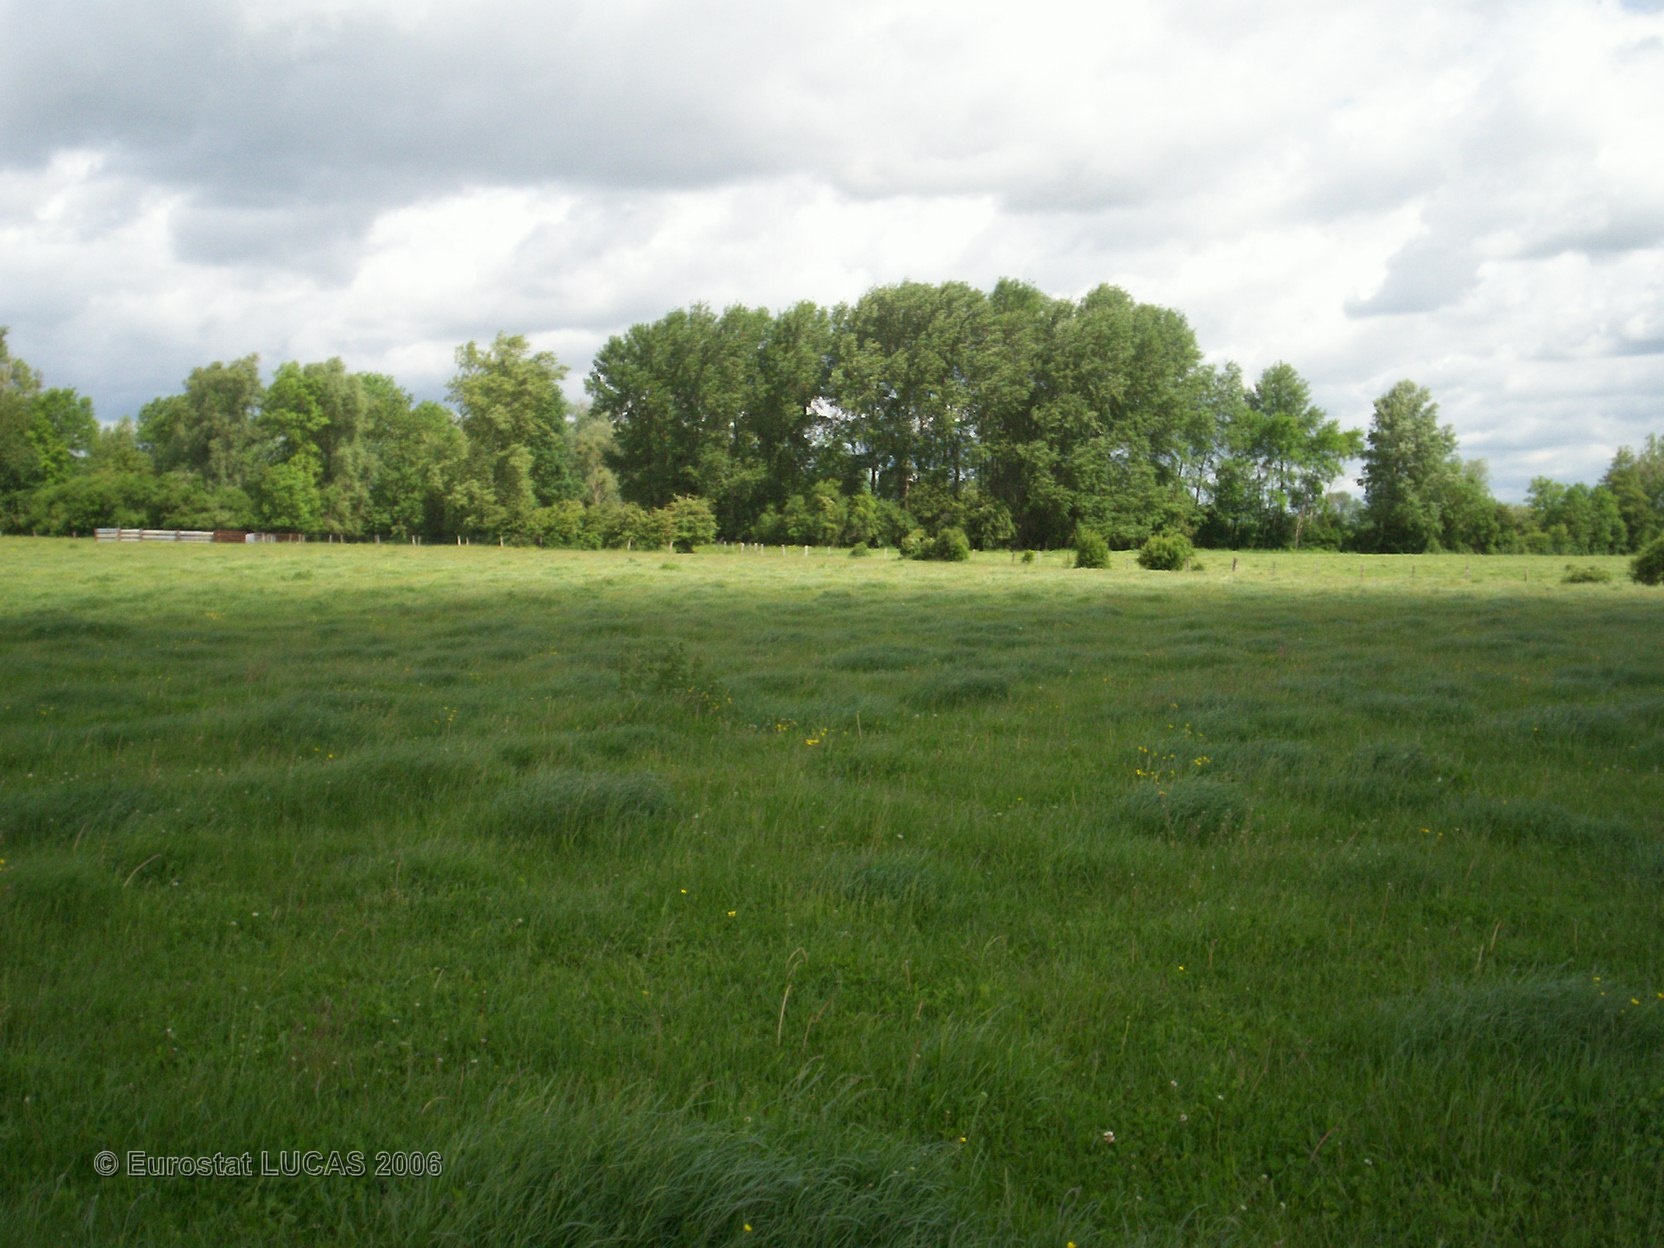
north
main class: Grassland
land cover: Grassland without tree/shrub cover
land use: Agriculture (excluding fallow land and kitchen gardens)
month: May
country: FR
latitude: 49.4894
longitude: 4.4327
